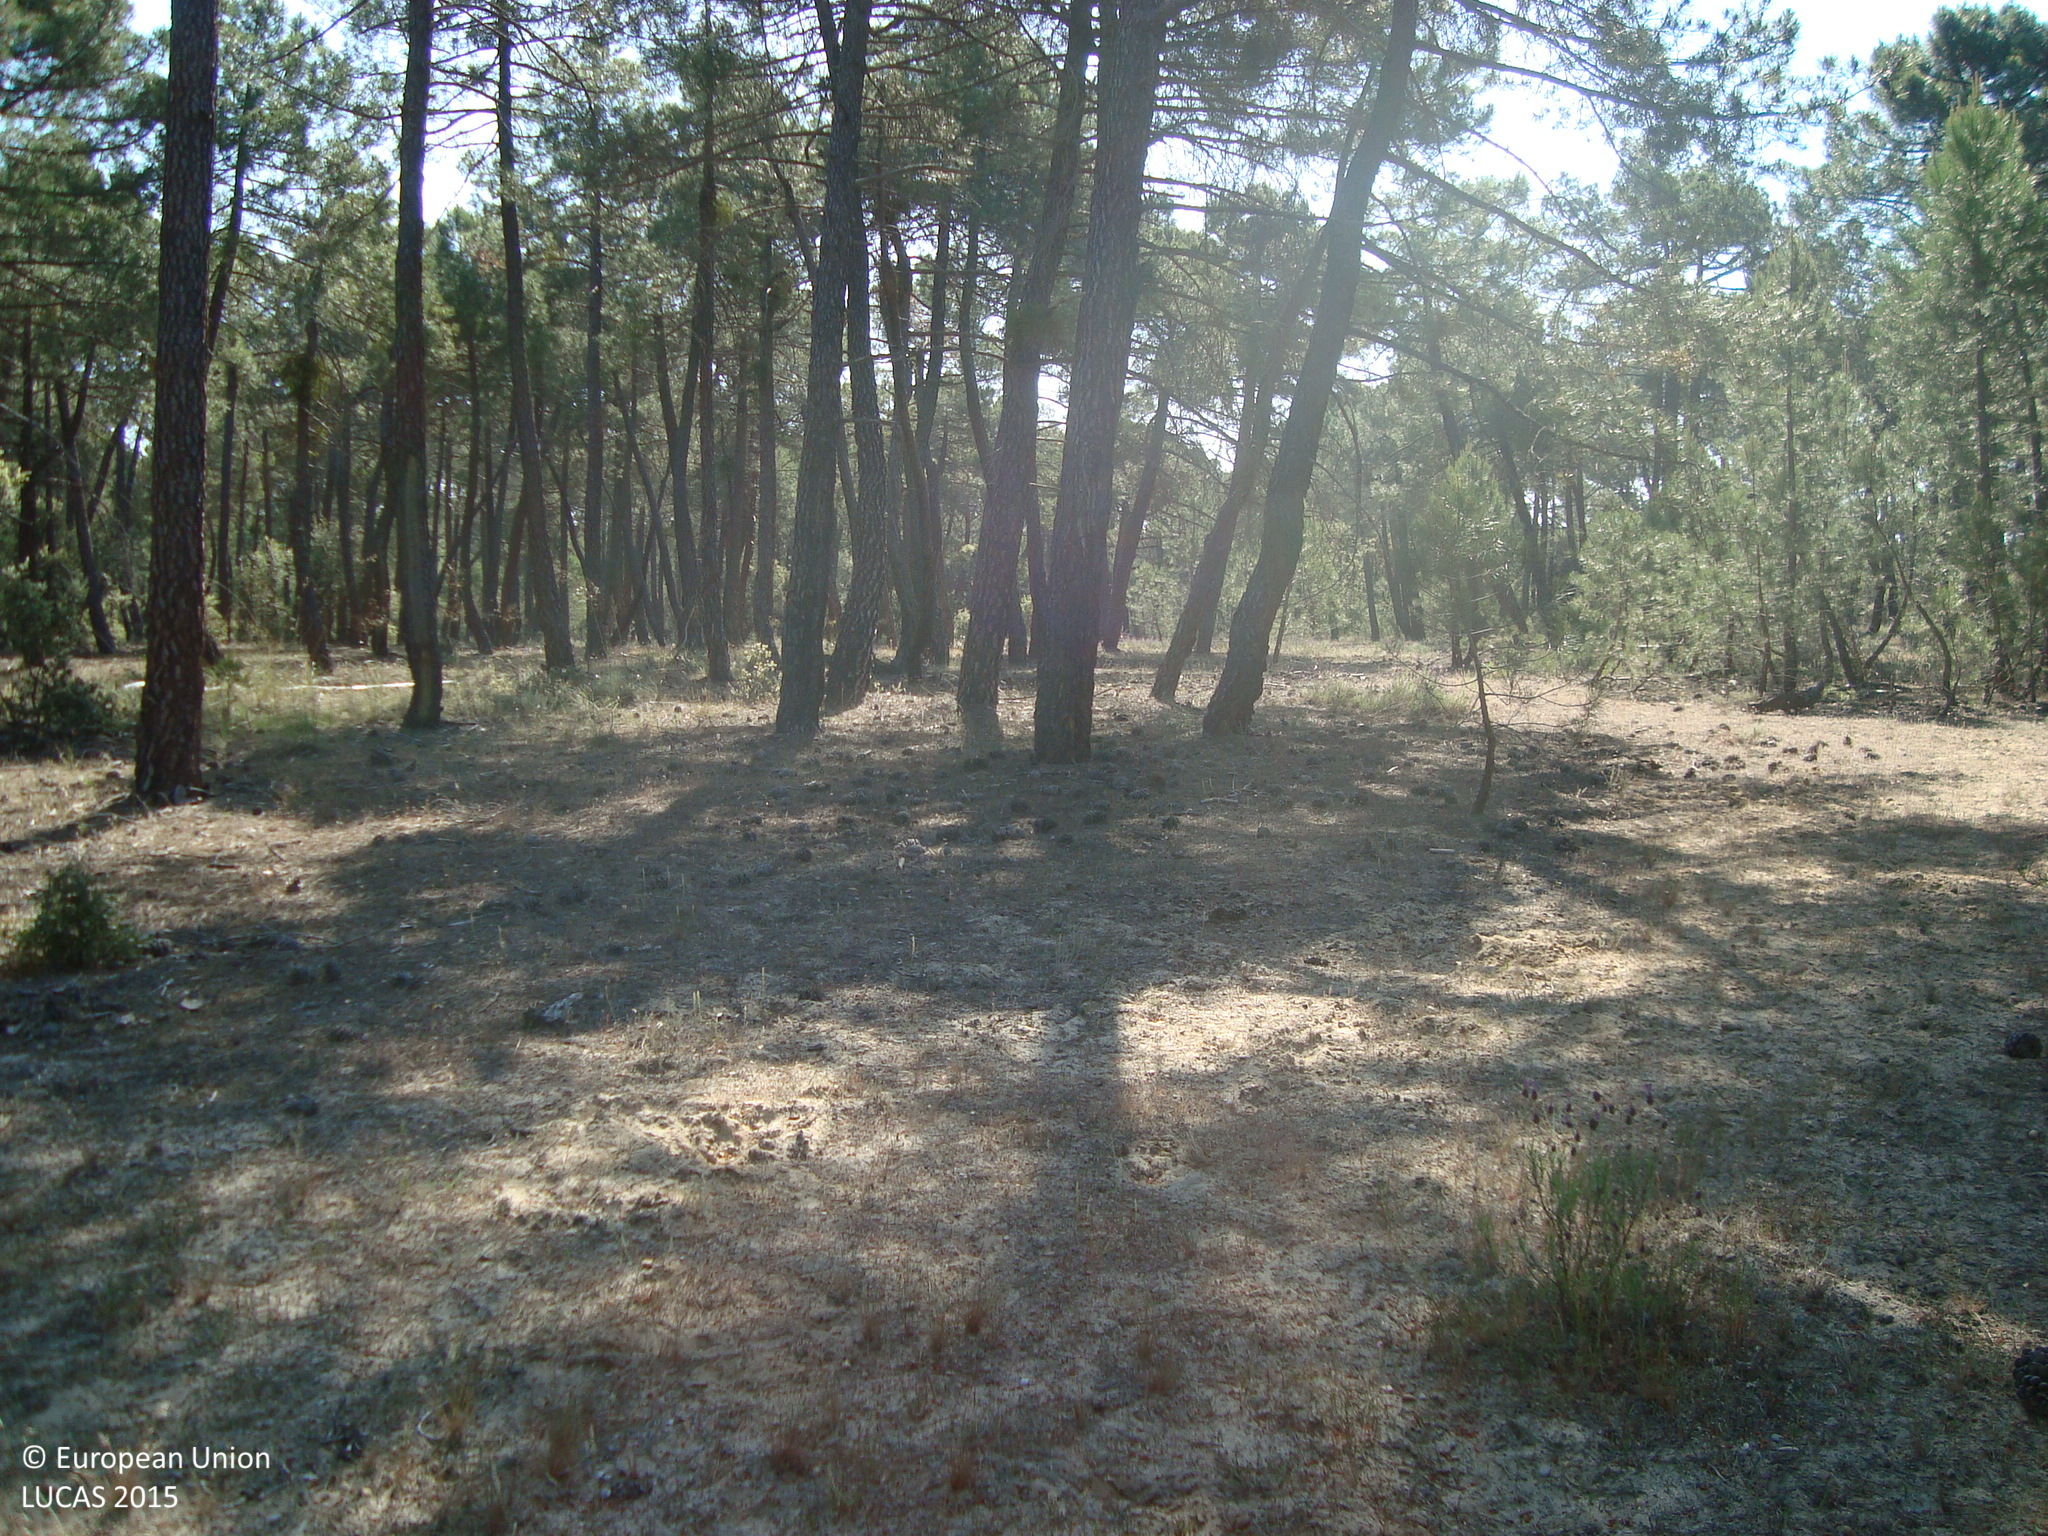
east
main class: Woodland
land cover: Pine dominated coniferous woodland
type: coniferous forest of the mediterranean region
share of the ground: 50 - 75 %
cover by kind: coniferous forest trees 55 %, unconsolidated bare surface 20 %, shrubs 10 %, herbaceous plants 10 %, broadleaved forest trees 5 %
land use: Forestry
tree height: > 5 m
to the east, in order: Pine dominated coniferous woodland
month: June
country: ES
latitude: 41.7317
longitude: -3.6015
